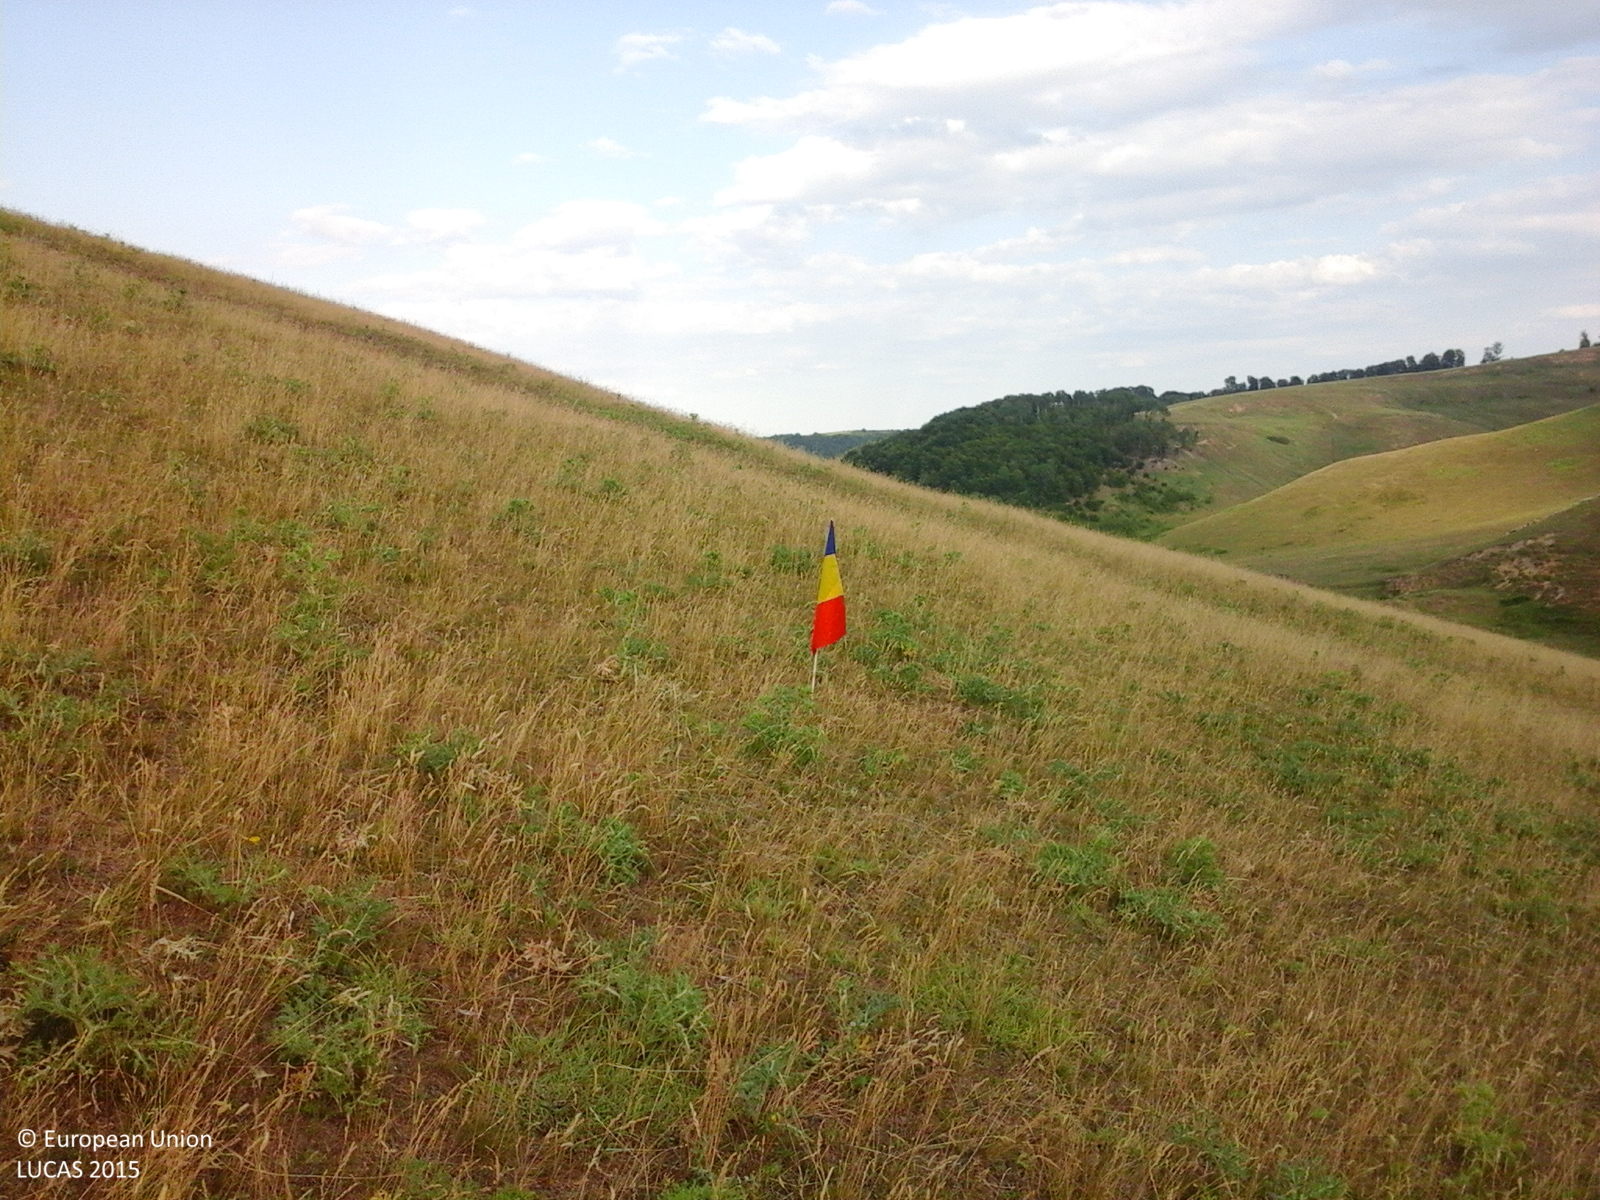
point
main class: Grassland
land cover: Grassland without tree/shrub cover
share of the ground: > 75 %
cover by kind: herbaceous plants 100 %
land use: Agriculture (excluding fallow land and kitchen gardens)
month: June
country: RO
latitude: 47.5506
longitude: 26.4179
